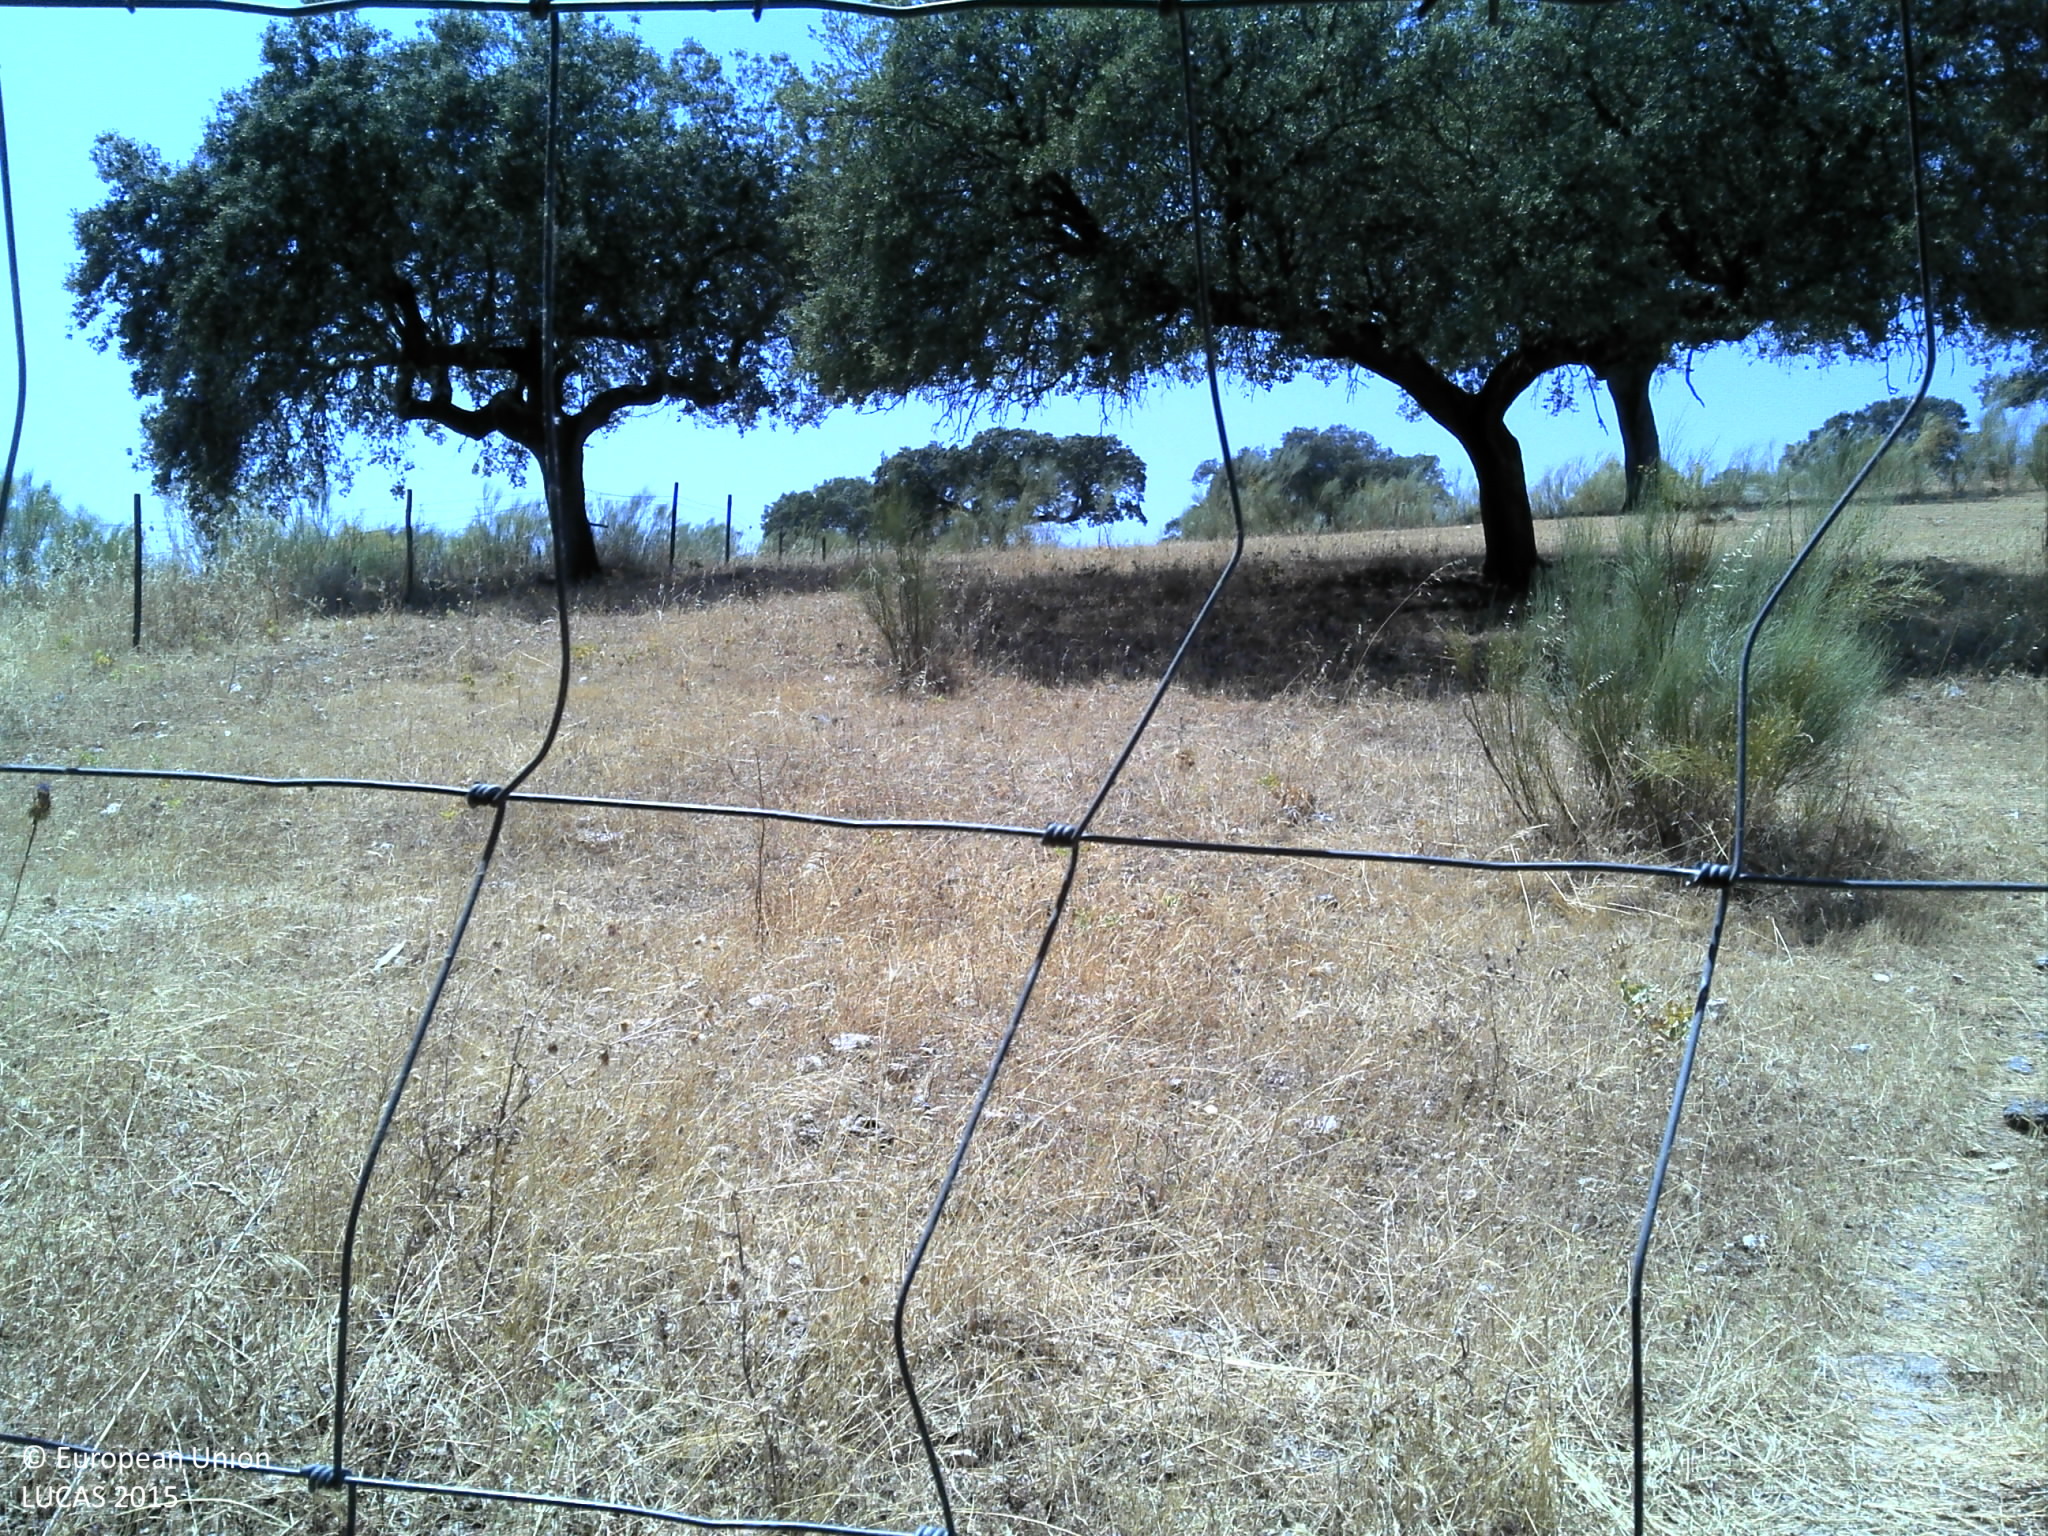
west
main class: Woodland
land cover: Broadleaved woodland
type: broadleaved evergreen forest
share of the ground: 50 - 75 %
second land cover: Grassland without tree/shrub cover
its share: 25 - 50 %
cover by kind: broadleaved forest trees 50 %, herbaceous plants 30 %, unconsolidated bare surface 20 %
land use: Forestry
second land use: Agriculture (excluding fallow land and kitchen gardens)
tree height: > 5 m
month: June
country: PT
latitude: 38.2105
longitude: -7.3450
